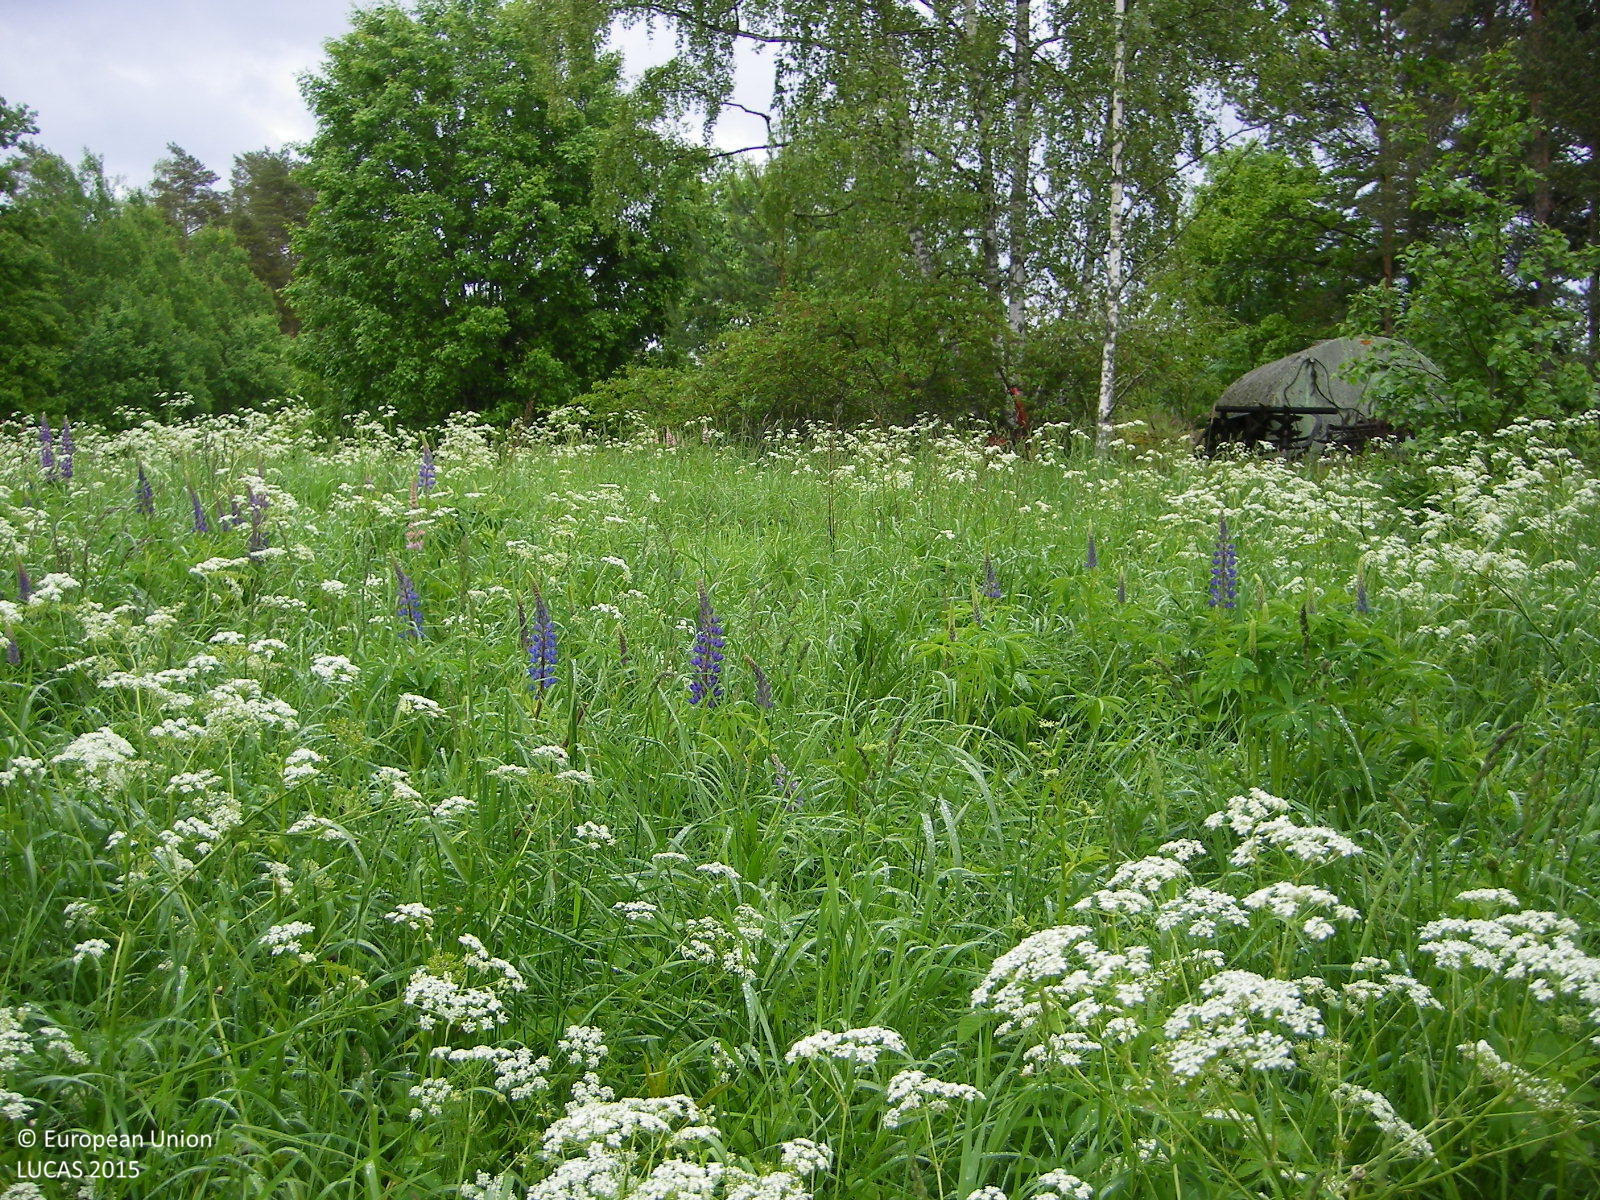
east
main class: Grassland
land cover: Spontaneously vegetated surfaces
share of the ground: > 75 %
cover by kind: herbaceous plants 100 %
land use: Fallow land
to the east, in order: Spontaneously vegetated surfaces; Broadleaved woodland; Spontaneously vegetated surfaces; Electric lines; Spontaneously vegetated surfaces; Ditches and canals; Artificial constructions in urban areas; Pine dominated mixed woodland; Grassland without tree/shrub cover
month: June
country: FI
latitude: 60.2237
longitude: 23.8693
